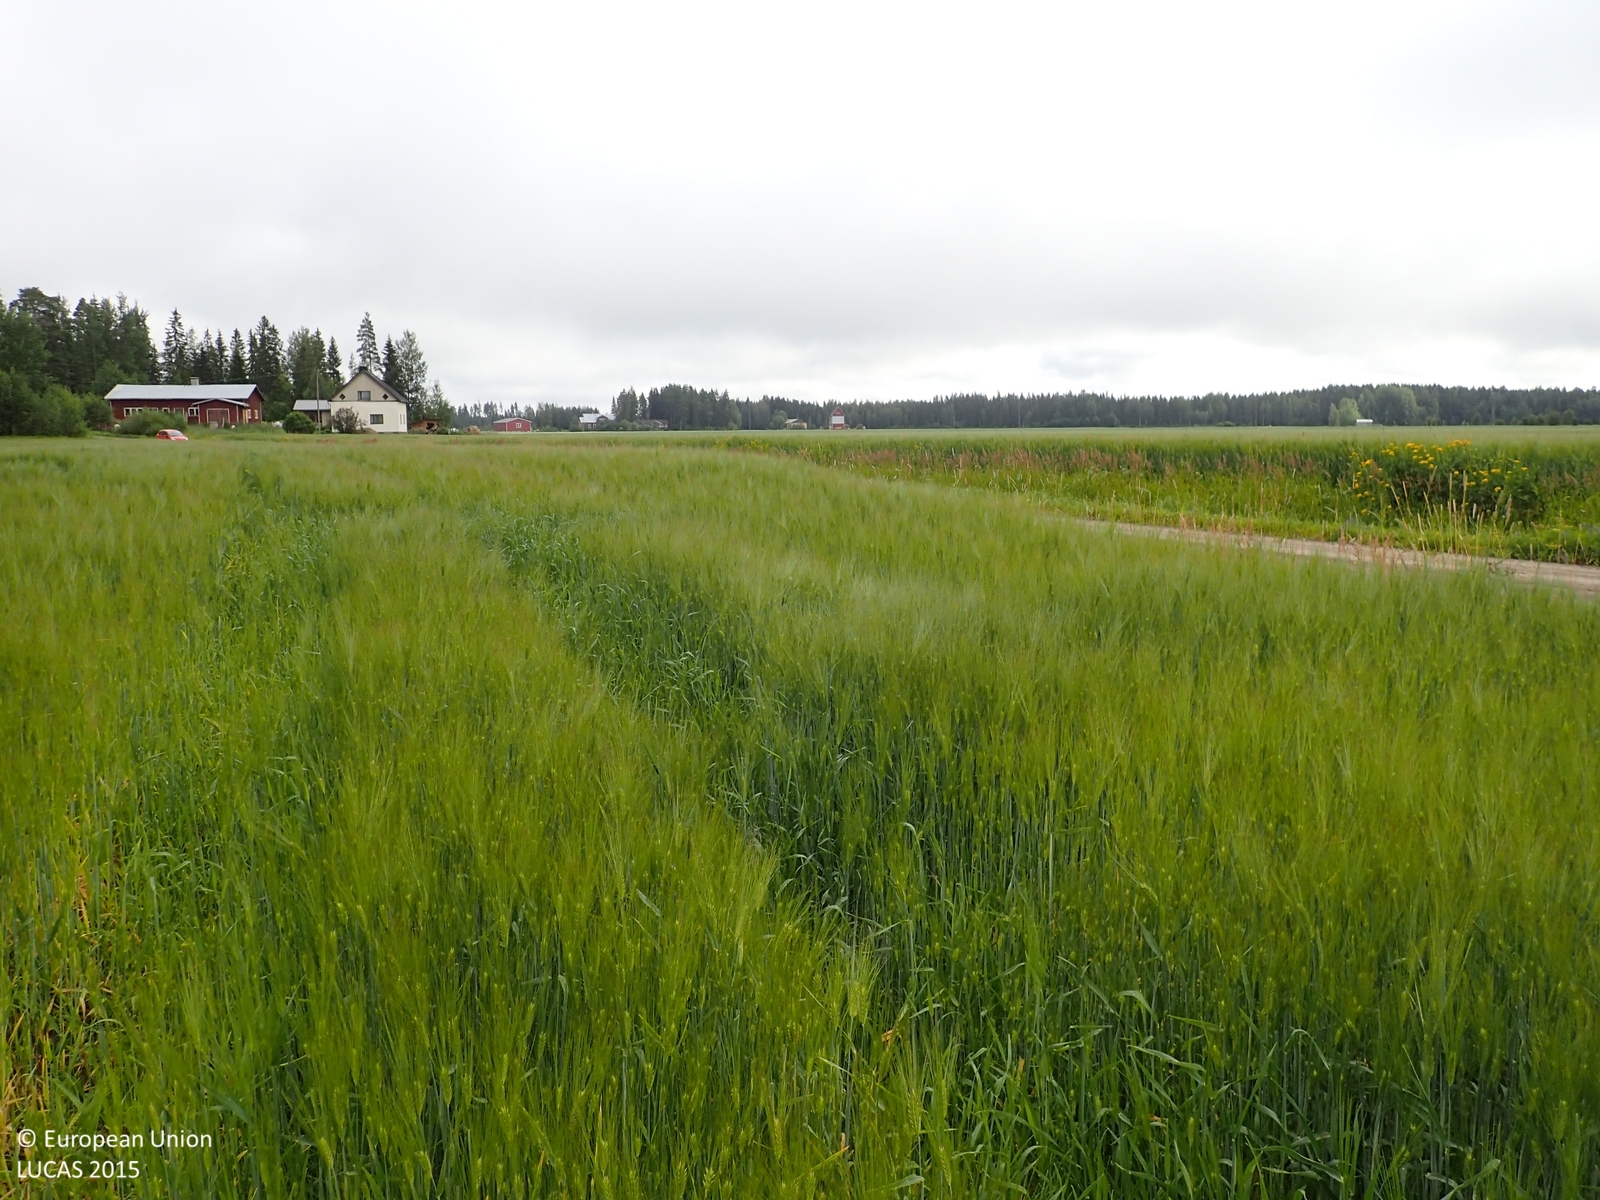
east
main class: Cropland
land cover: Oats
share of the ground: > 75 %
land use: Agriculture (excluding fallow land and kitchen gardens)
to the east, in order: Oats; Barley; Shruby margins; Ditches and canals; Grass margins; Paved roads, cycling and walking lanes; Grass margins; Ditches and canals; Shruby margins; Barley; Ditches and canals; Oats
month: July
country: FI
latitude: 62.9679
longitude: 22.4964
